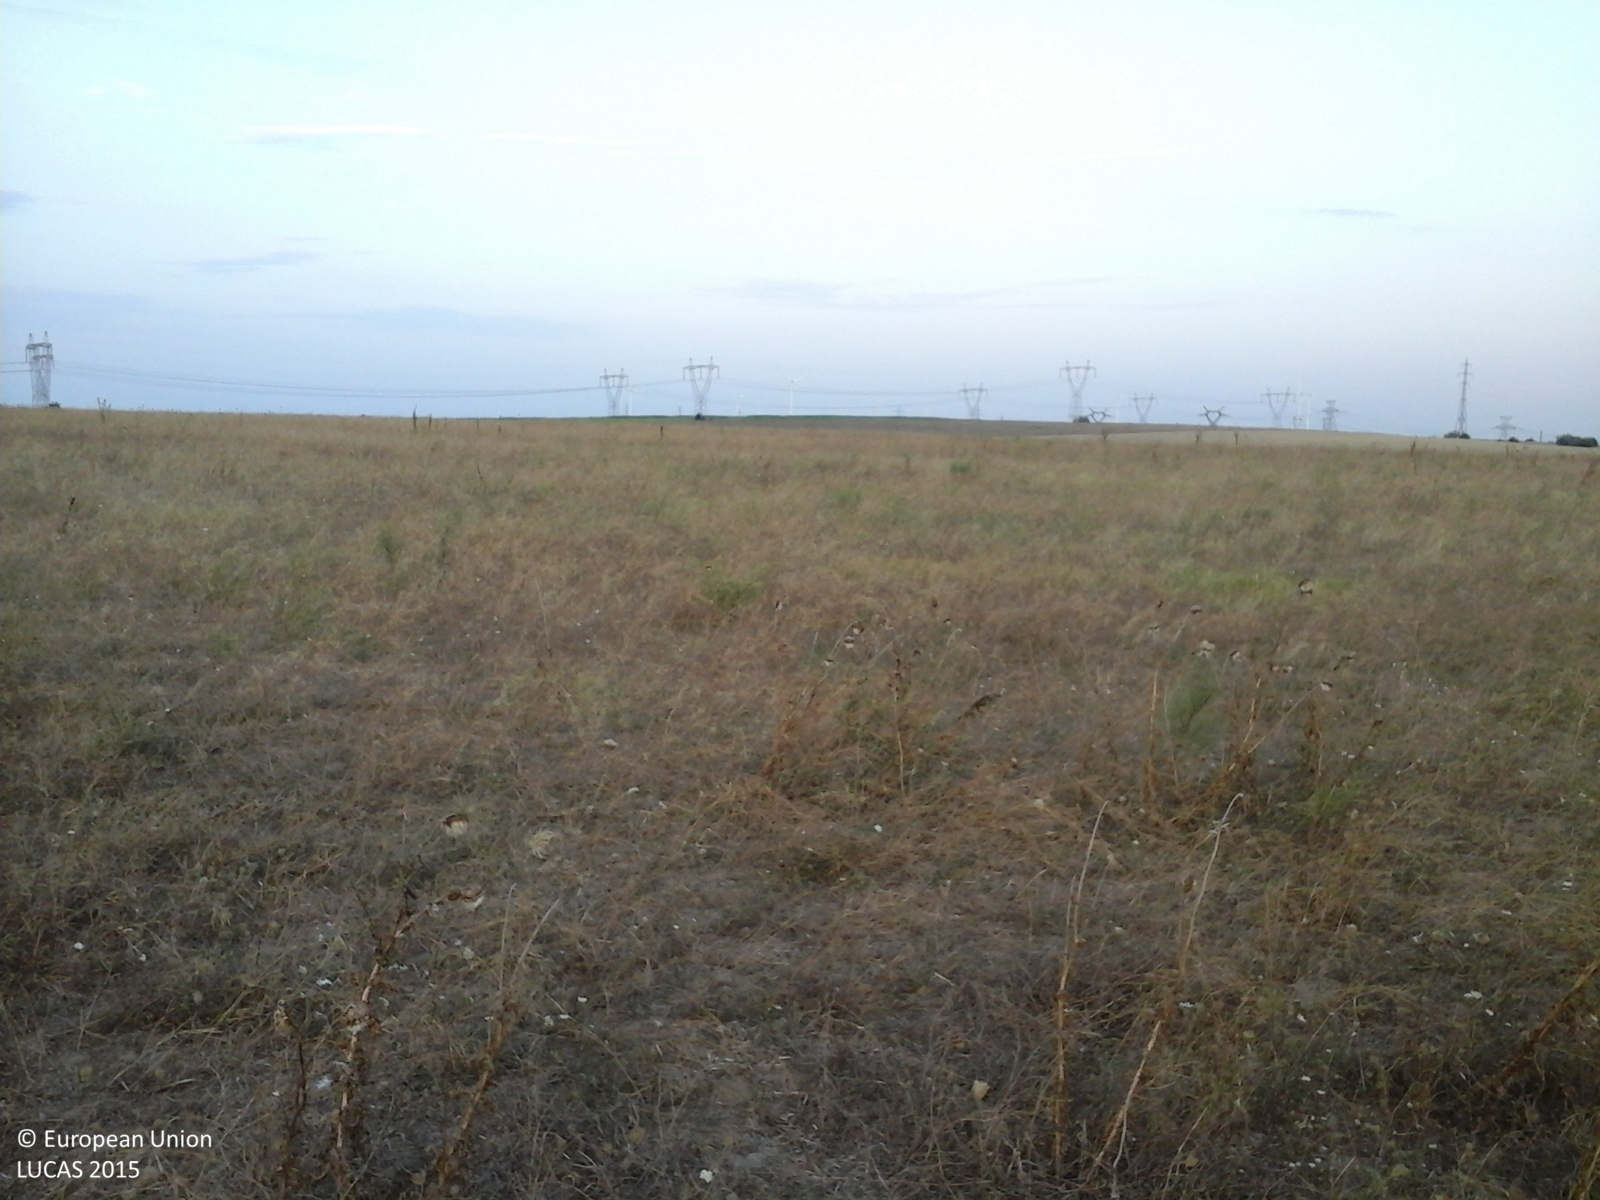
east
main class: Grassland
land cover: Spontaneously vegetated surfaces
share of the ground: > 75 %
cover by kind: herbaceous plants 100 %
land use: Agriculture (excluding fallow land and kitchen gardens)
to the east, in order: Spontaneously vegetated surfaces; Common wheat
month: August
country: RO
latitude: 44.3370
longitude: 28.0552
